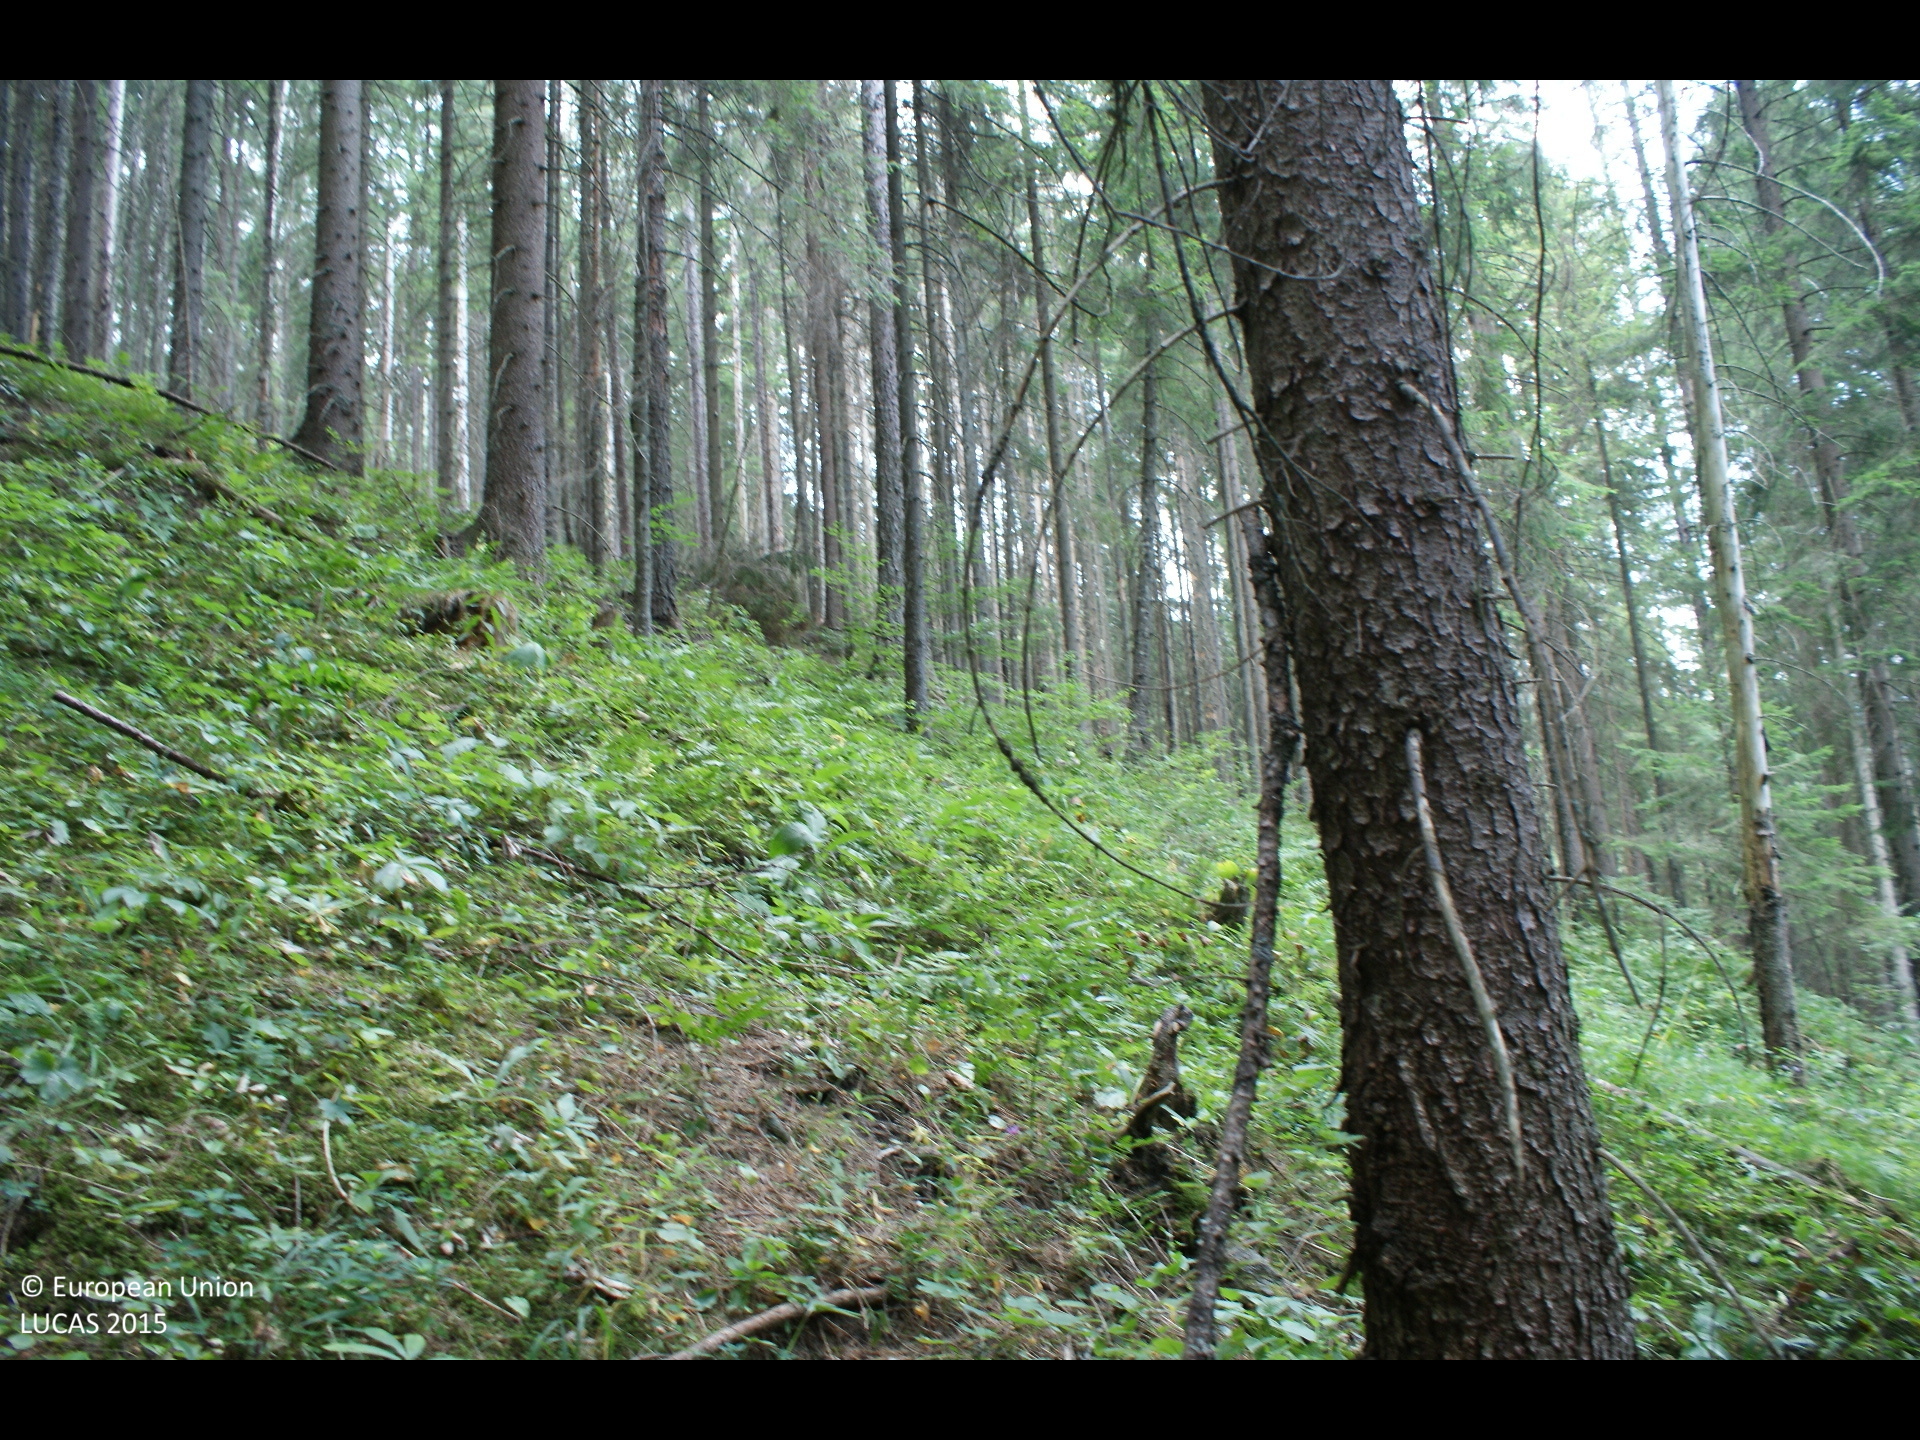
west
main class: Woodland
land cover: Spruce dominated coniferous woodland
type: alpine coniferous forest
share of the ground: > 75 %
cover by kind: coniferous forest trees 80 %, herbaceous plants 10 %, lichens and mosses 10 %
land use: Forestry
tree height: > 5 m
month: August
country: AT
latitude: 47.7344
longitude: 15.3215
